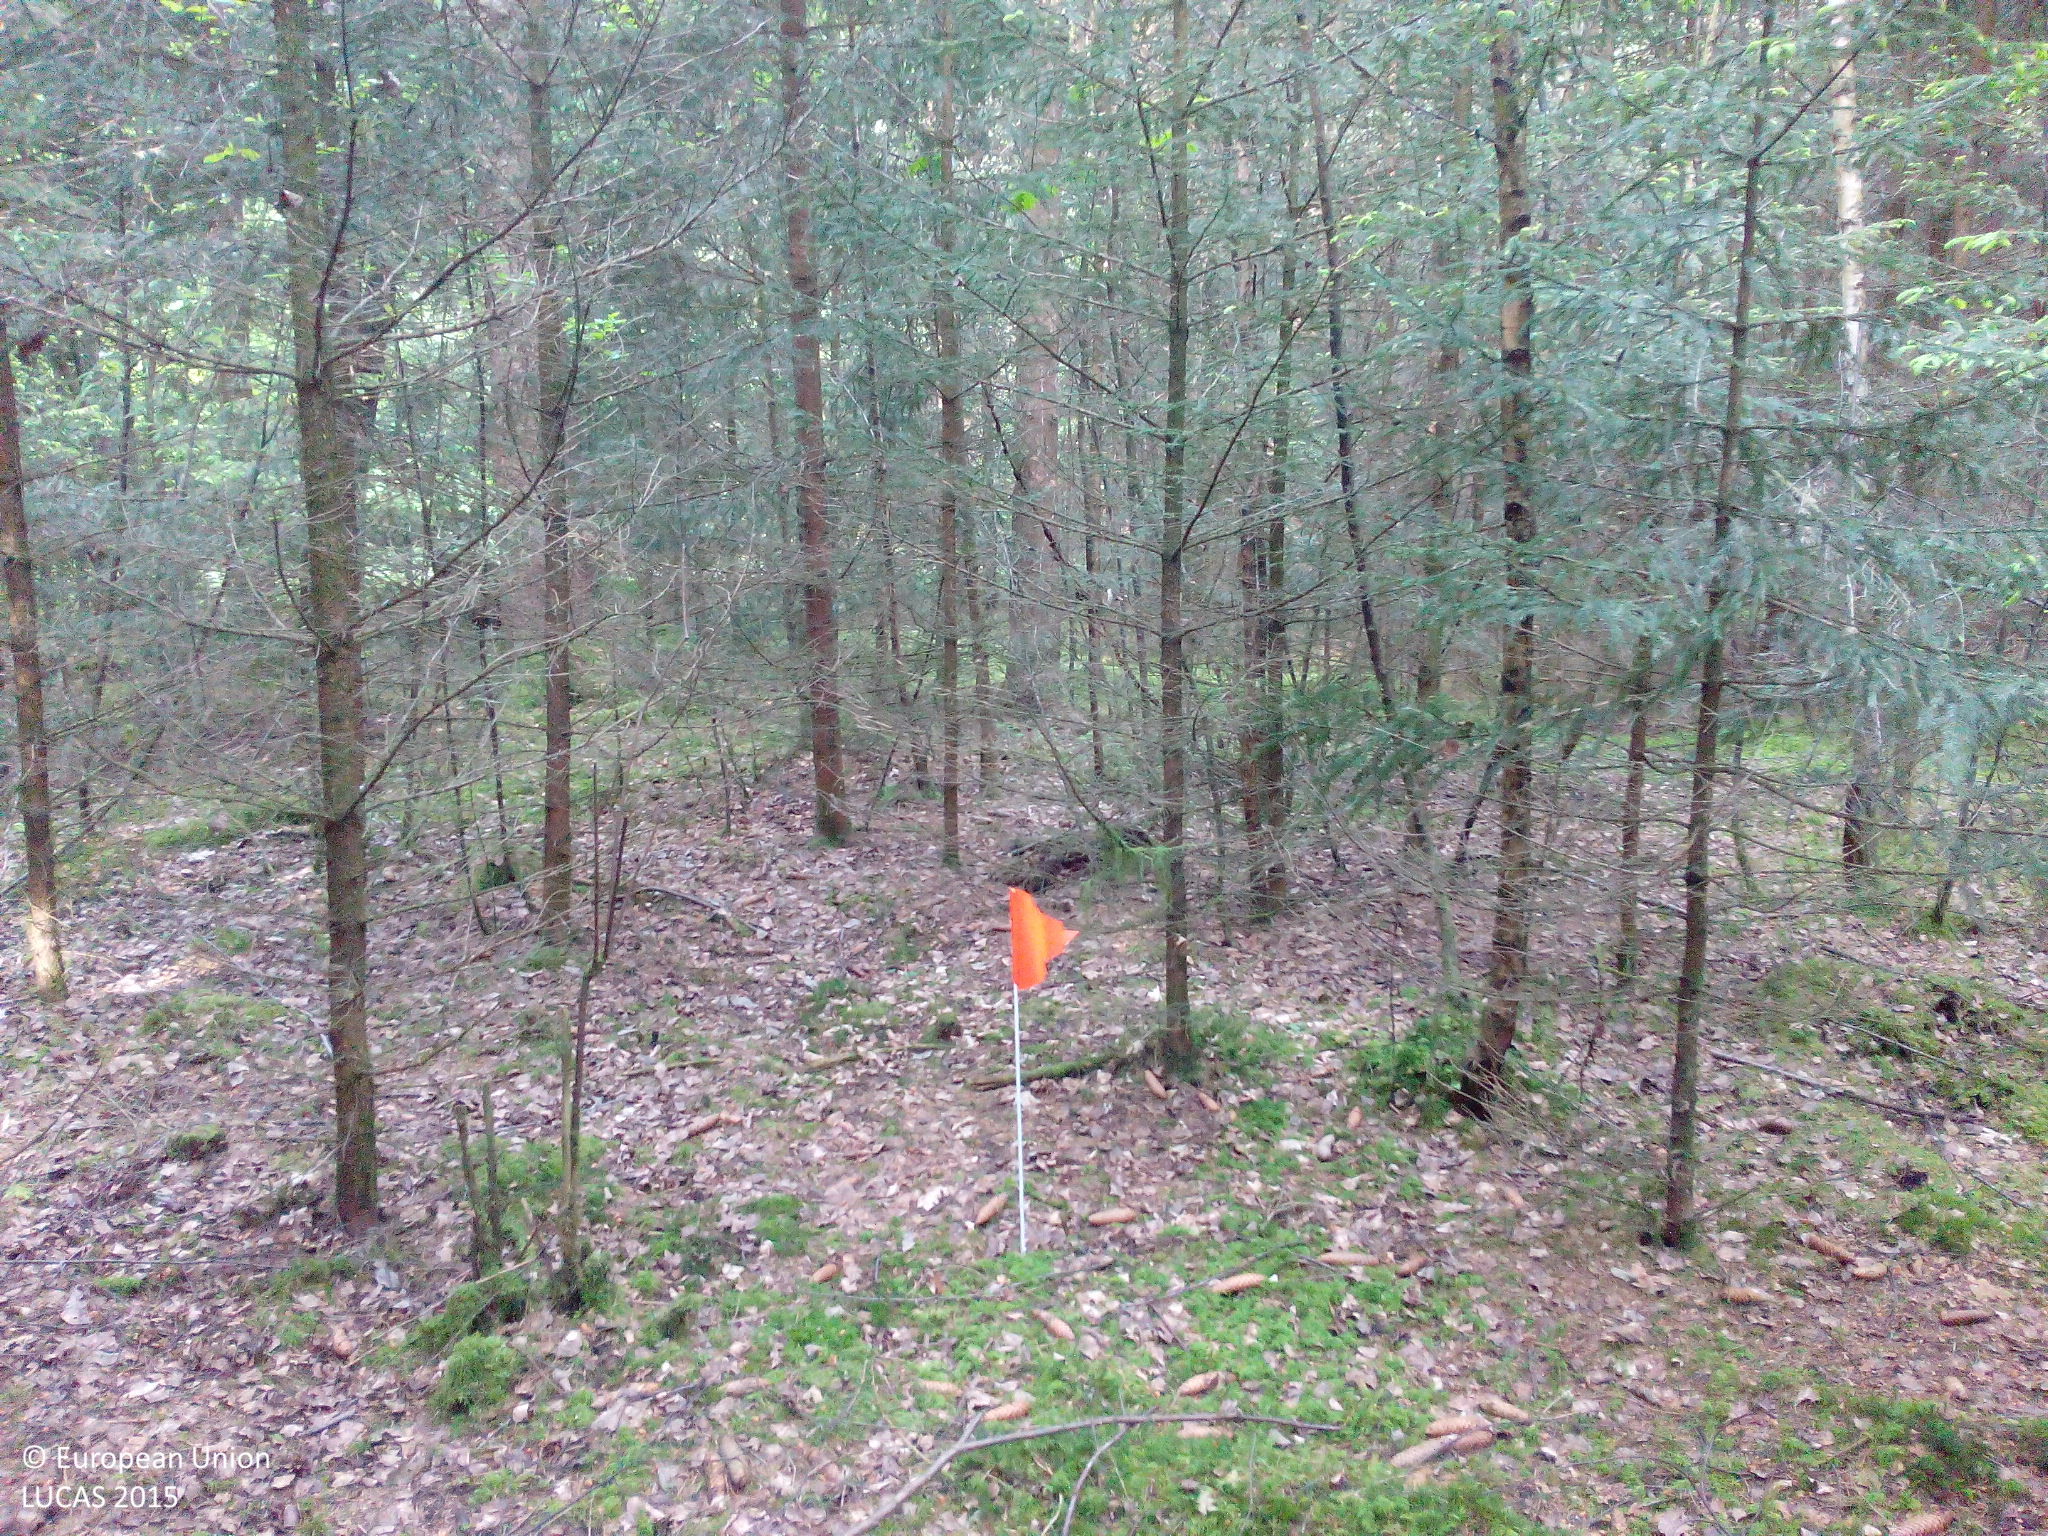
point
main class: Woodland
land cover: Spruce dominated coniferous woodland
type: hemiboreal forest and nemoral coniferous forest and mixed broadleaved-coniferous forest
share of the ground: > 75 %
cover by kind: coniferous forest trees 90 %, broadleaved forest trees 10 %
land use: Forestry
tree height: > 5 m
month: May
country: DE
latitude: 49.3376
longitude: 10.5640
